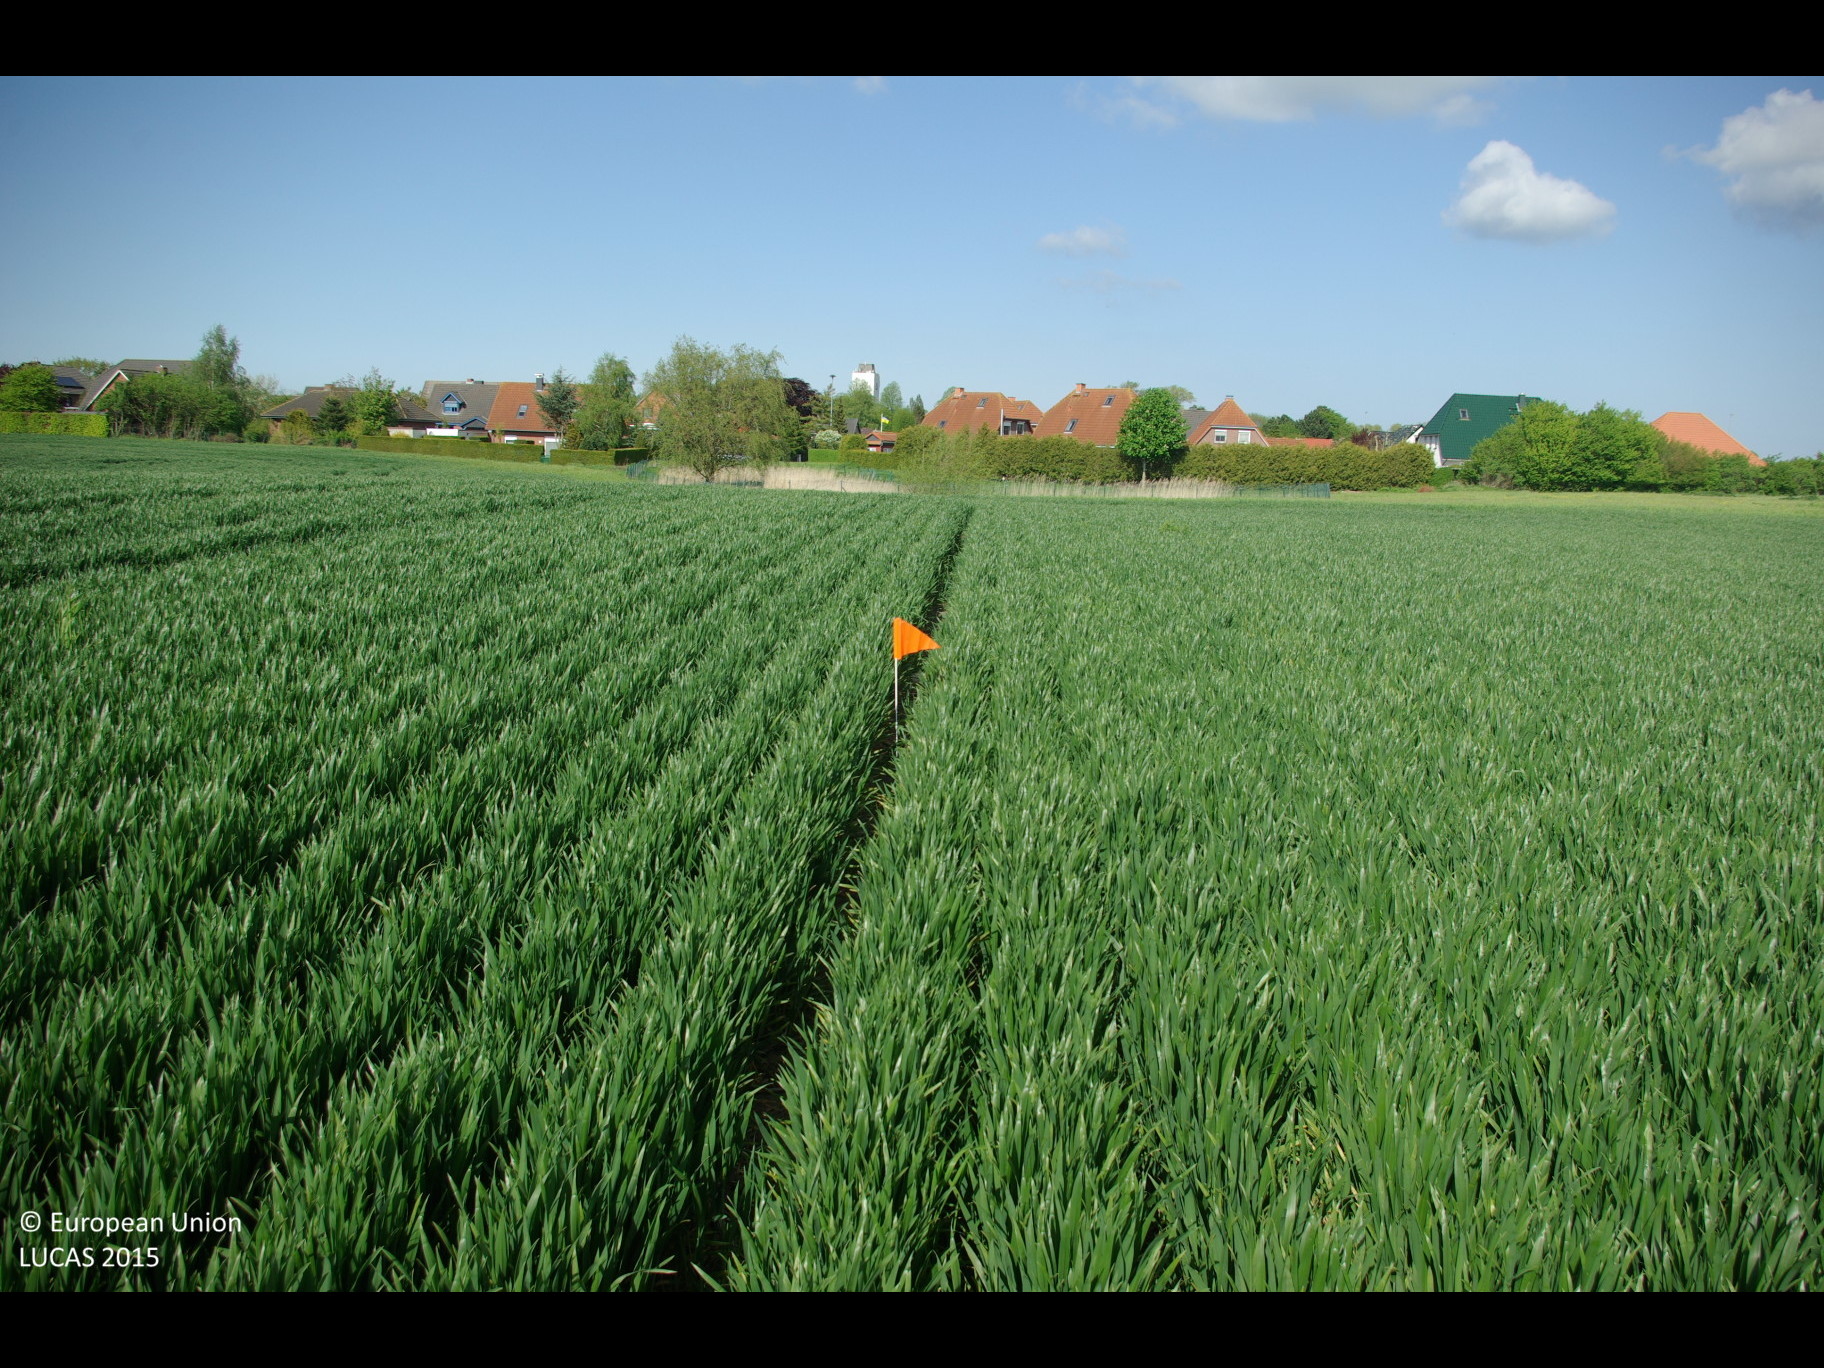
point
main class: Cropland
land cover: Common wheat
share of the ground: > 75 %
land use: Agriculture (excluding fallow land and kitchen gardens)
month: May
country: DE
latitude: 54.2965
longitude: 10.9981
